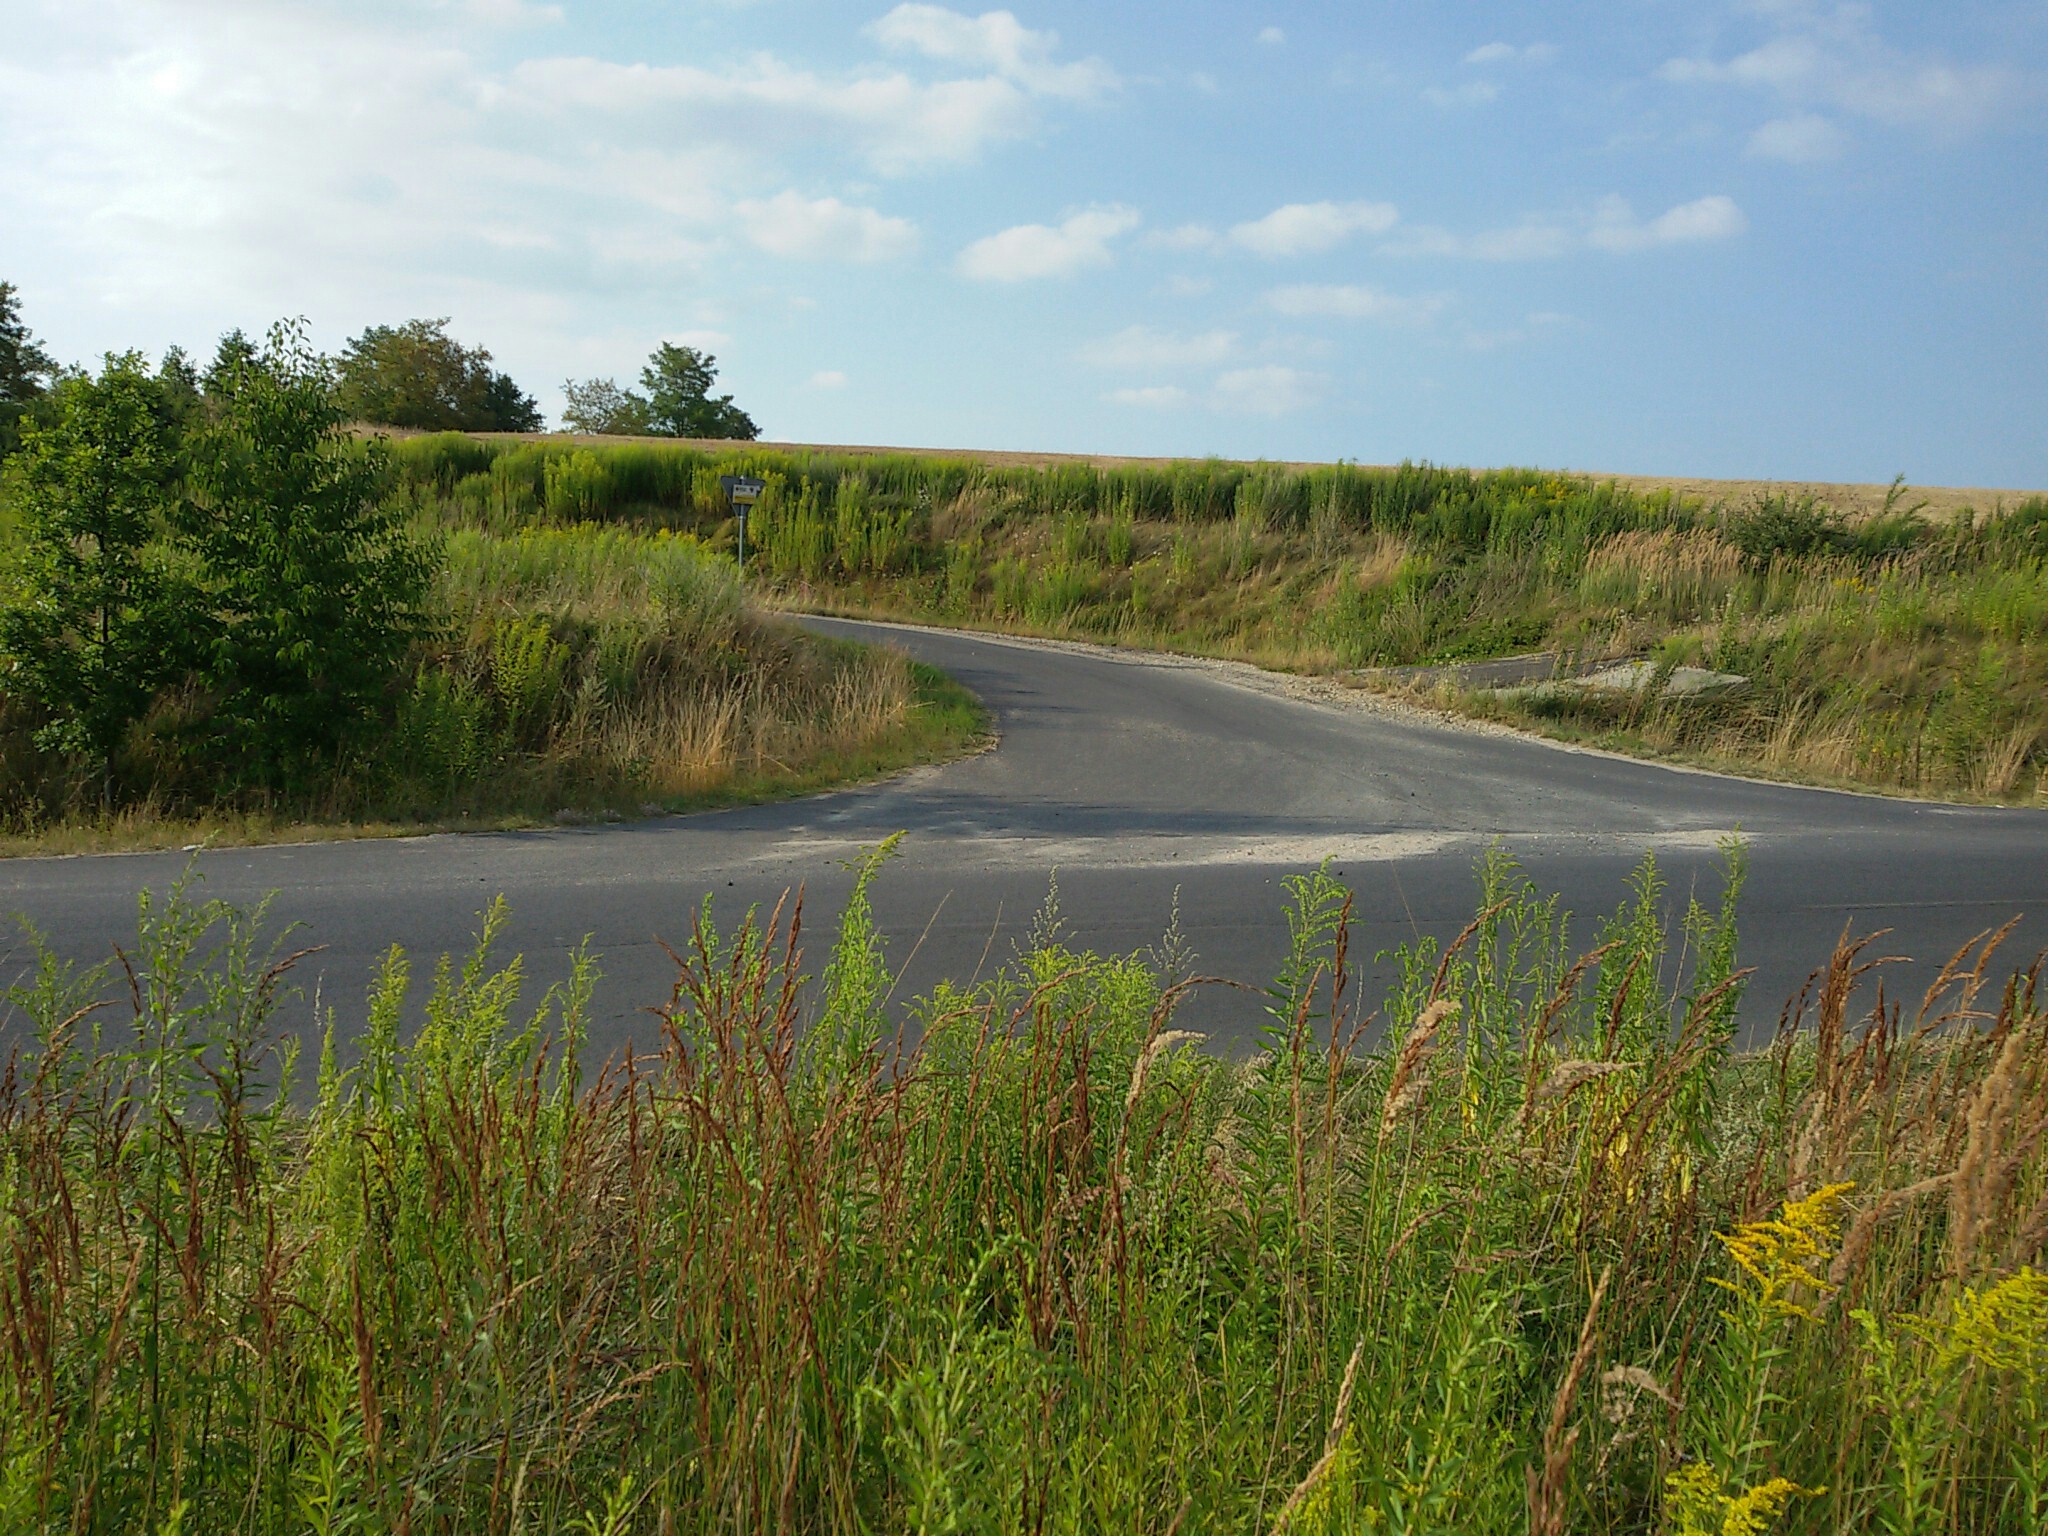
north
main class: Grassland
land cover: Spontaneously vegetated surfaces
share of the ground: > 75 %
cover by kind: herbaceous plants 100 %
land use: Semi-natural and natural areas not in use
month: August
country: PL
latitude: 51.1946
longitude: 15.7145
